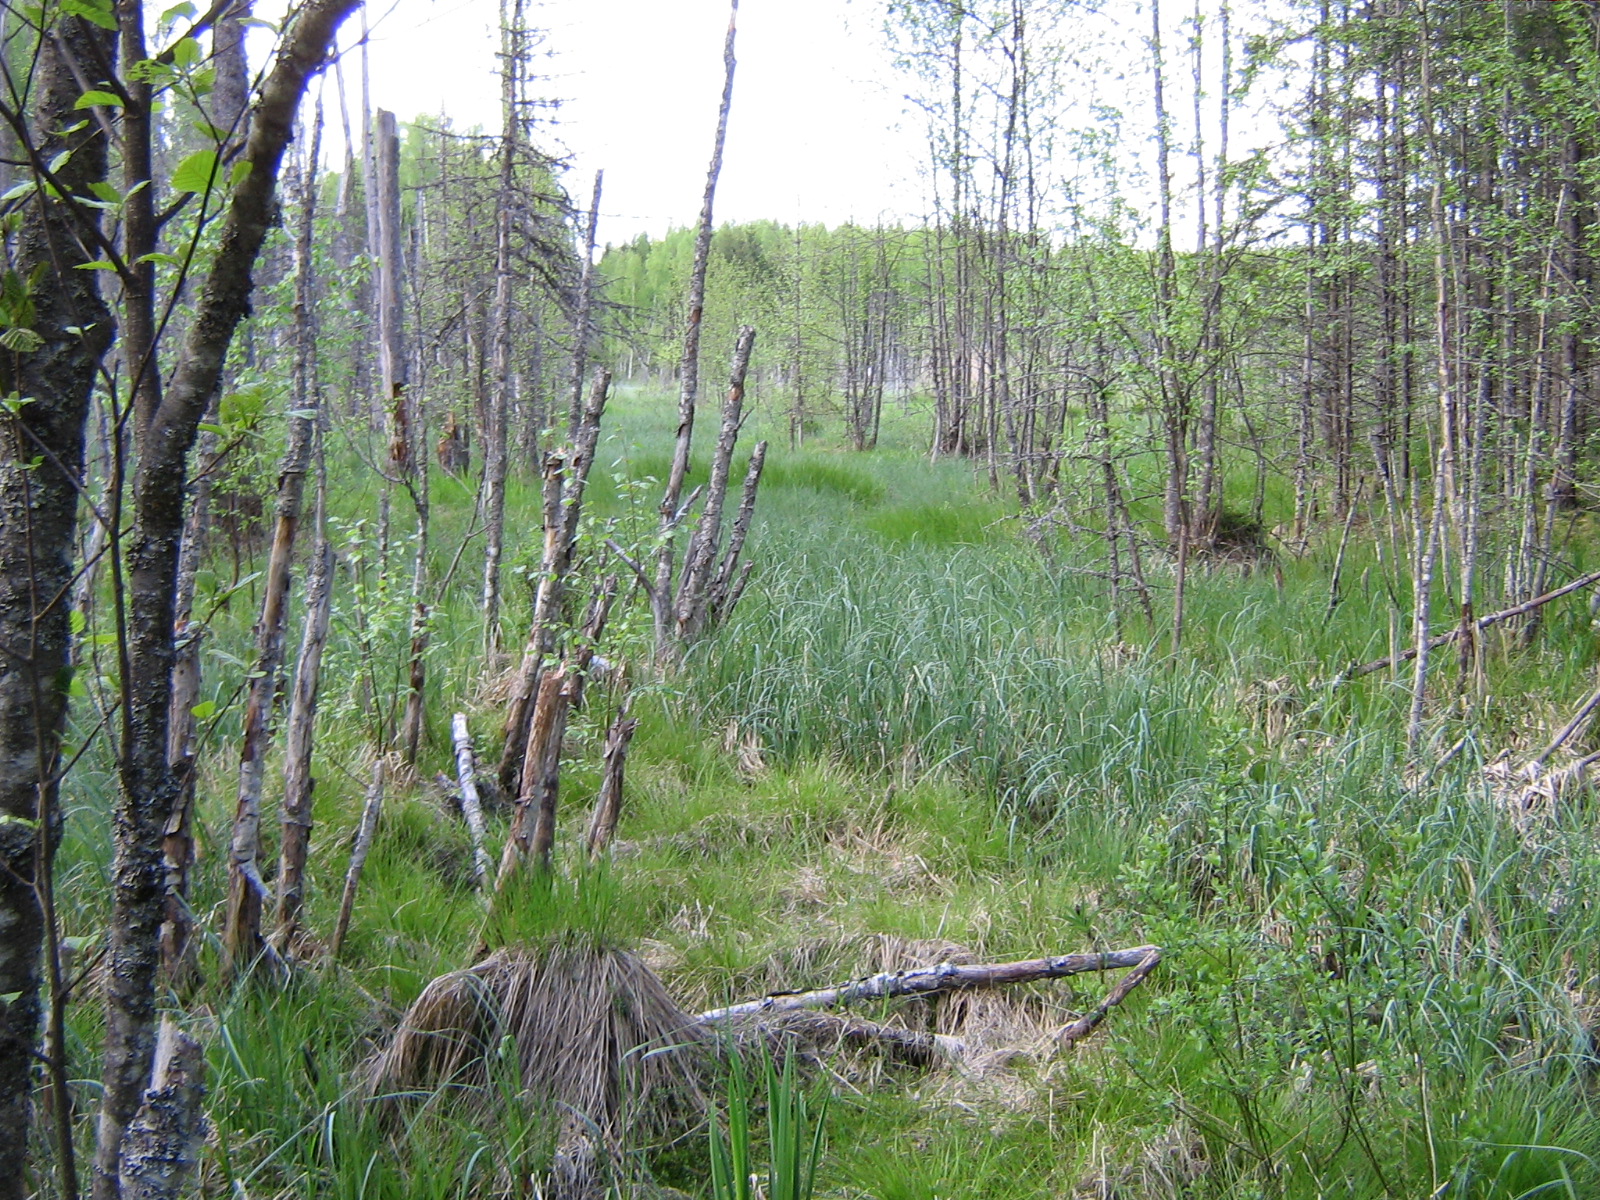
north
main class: Woodland
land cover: Broadleaved woodland
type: floodplain forest
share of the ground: 50 - 75 %
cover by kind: broadleaved forest trees 70 %, herbaceous plants 15 %, lichens and mosses 15 %
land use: Semi-natural and natural areas not in use
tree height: > 5 m
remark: Temporary flooded
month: May
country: LV
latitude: 57.3031
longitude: 25.8775
